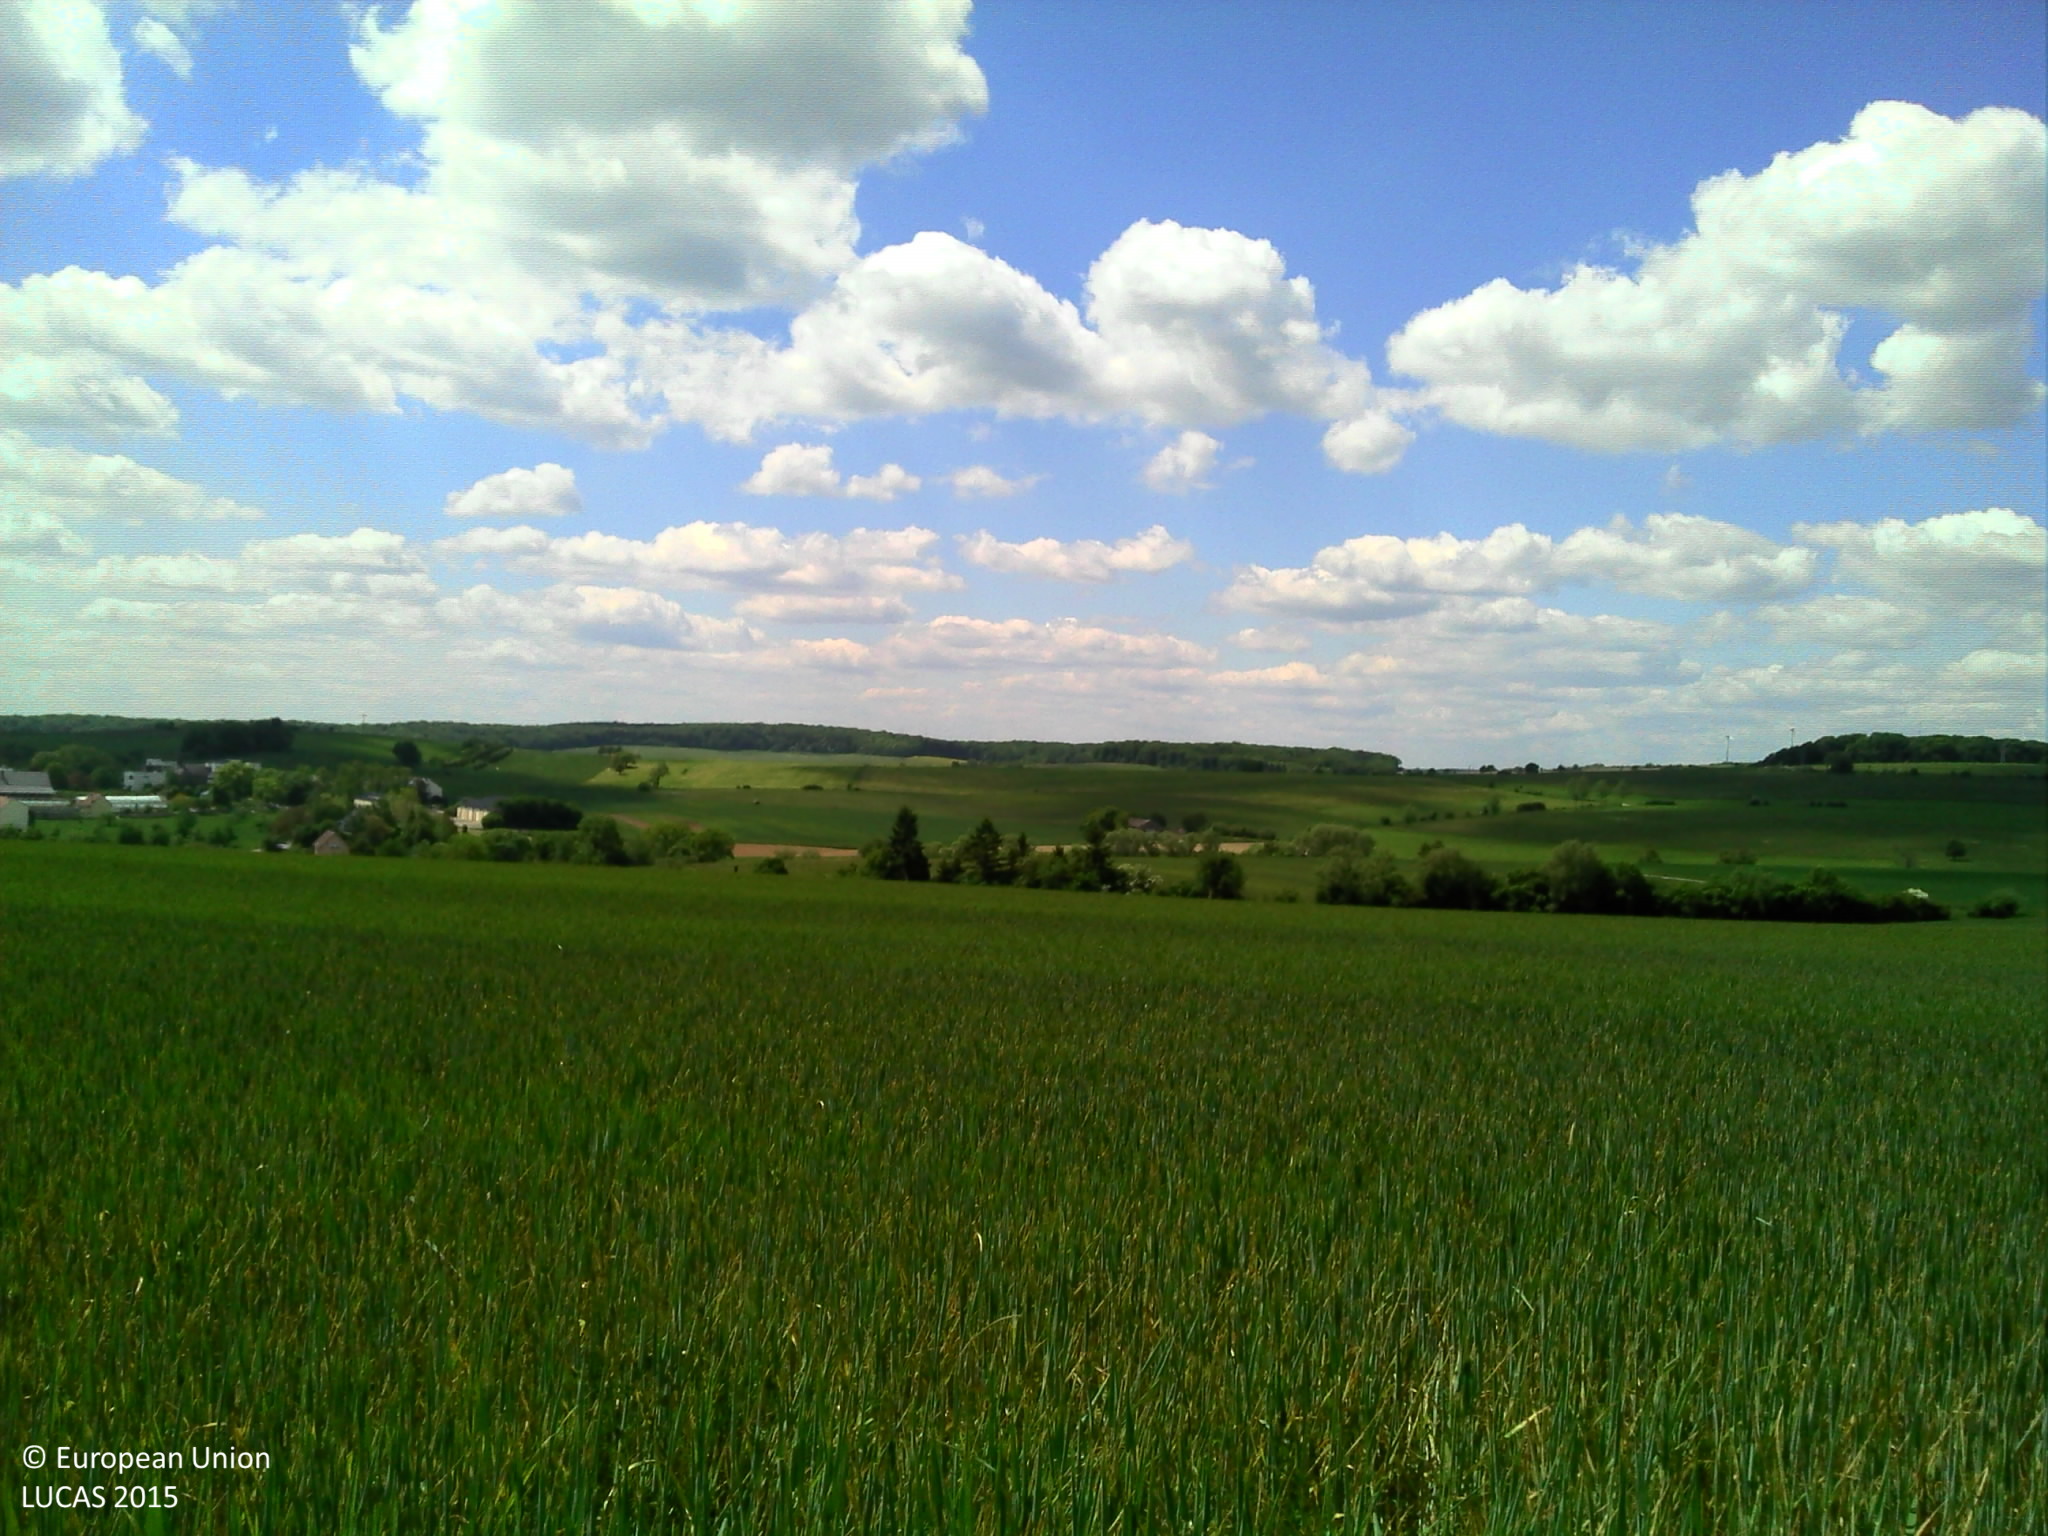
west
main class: Cropland
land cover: Common wheat
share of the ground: > 75 %
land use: Agriculture (excluding fallow land and kitchen gardens)
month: May
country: LU
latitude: 49.7522
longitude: 6.4882
